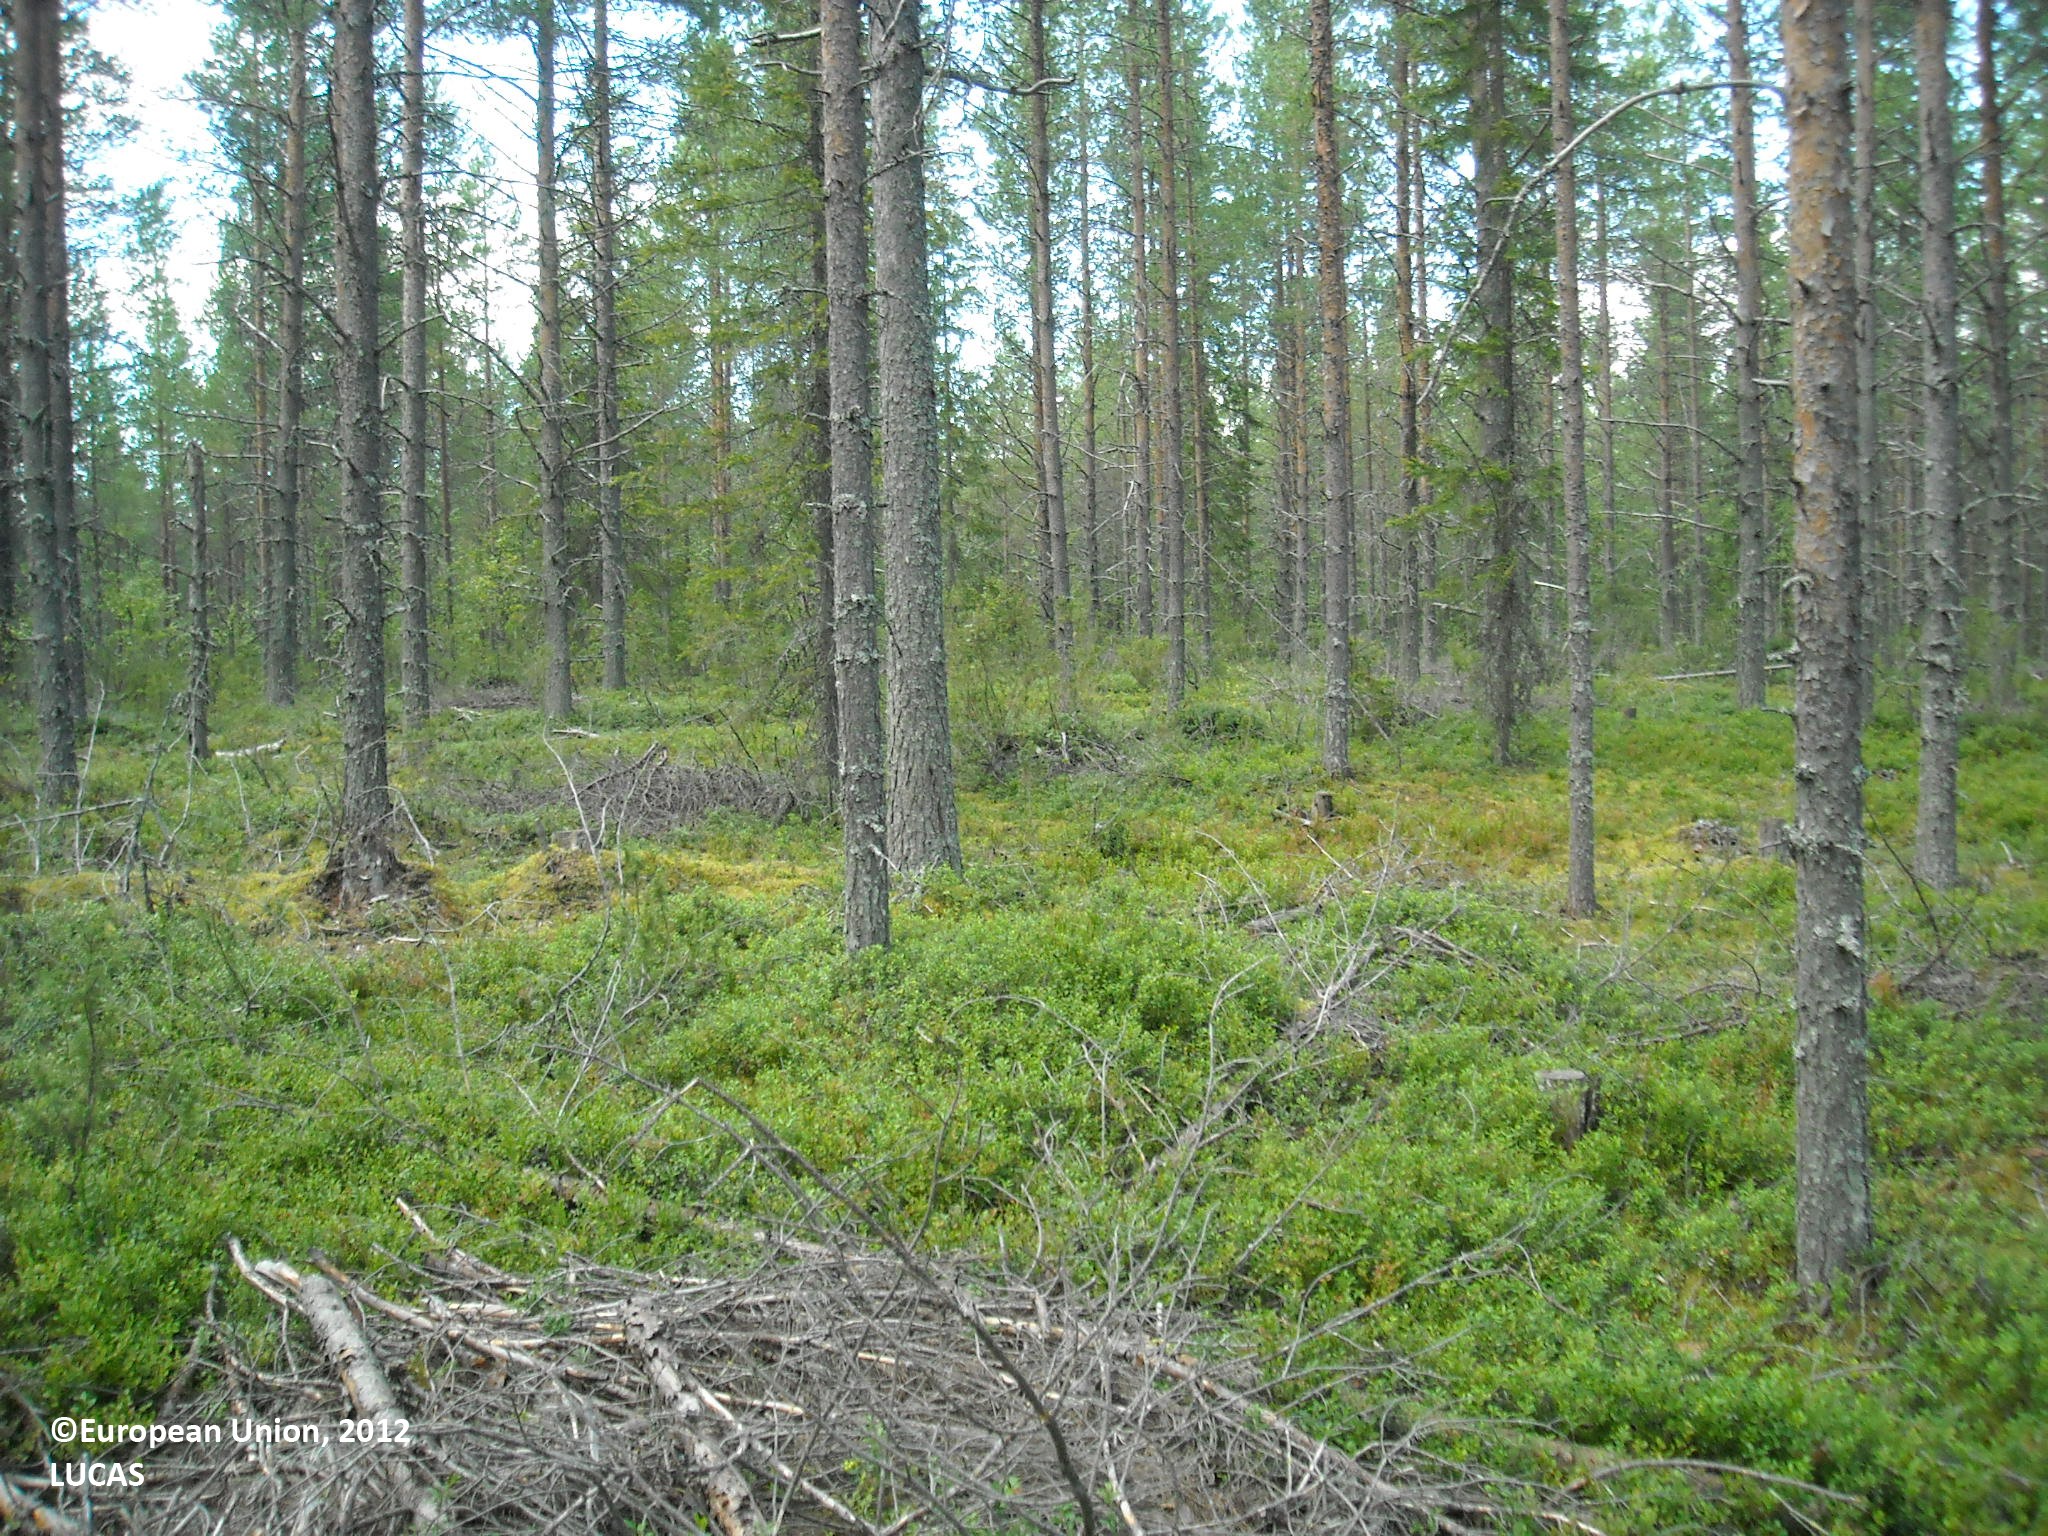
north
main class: Woodland
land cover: Pine dominated coniferous woodland
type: boreal forest
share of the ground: 50 - 75 %
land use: Forestry
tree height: > 5 m
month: August
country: FI
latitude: 65.3906
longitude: 27.8093
